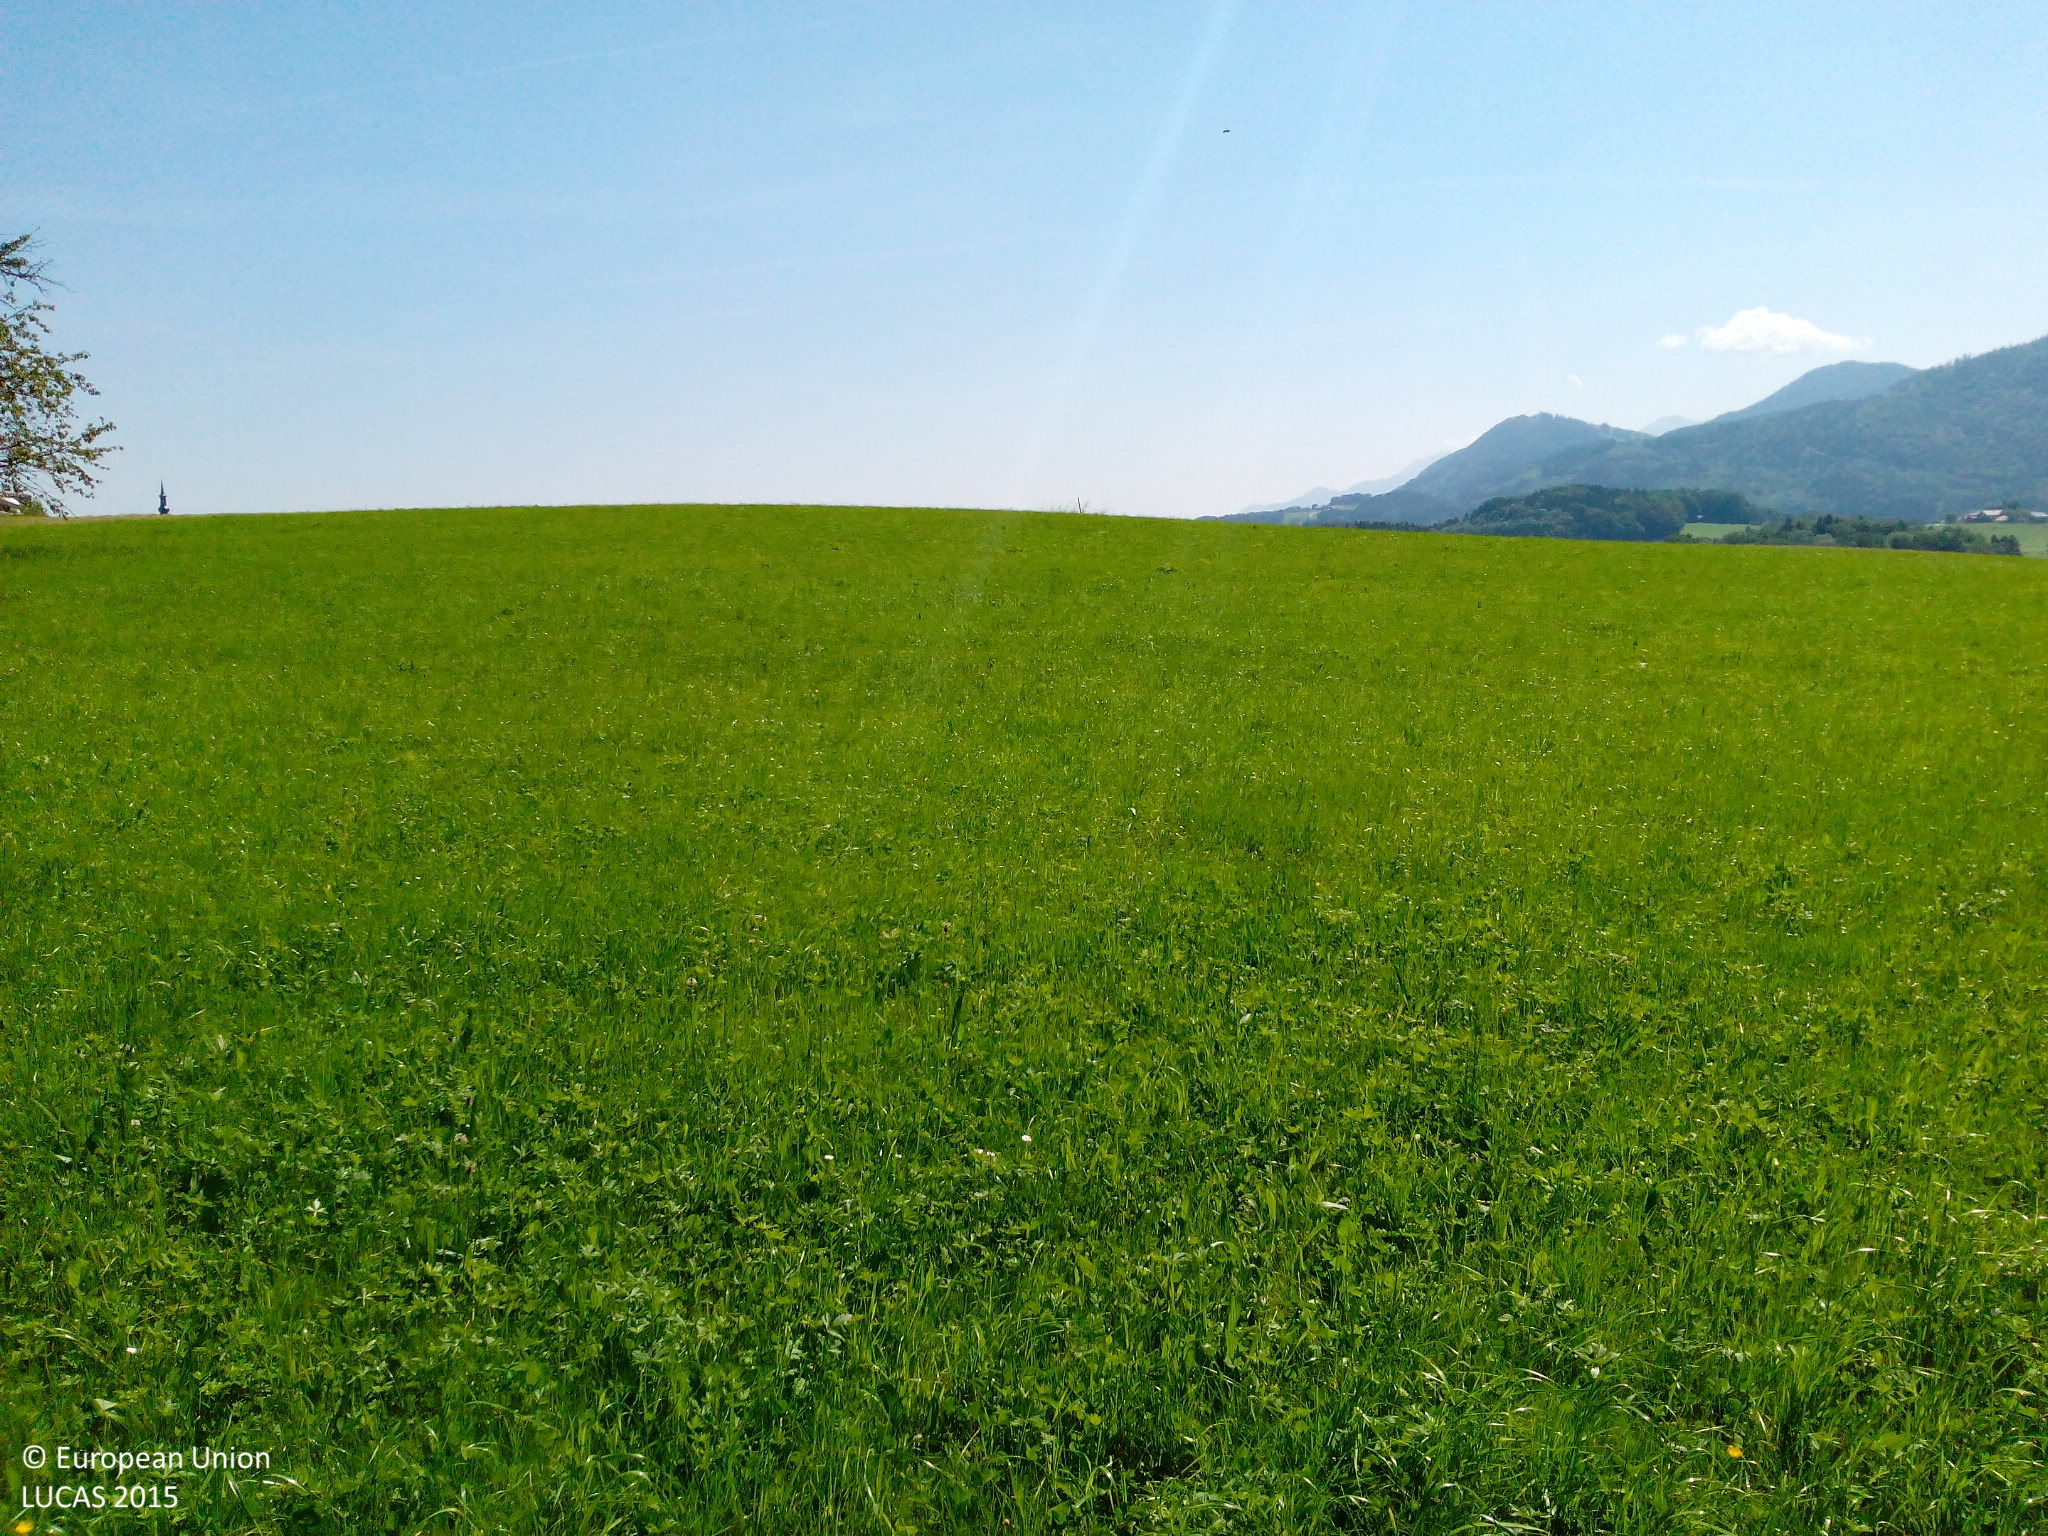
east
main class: Cropland
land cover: Apple fruit
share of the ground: 50 - 75 %
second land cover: Grassland without tree/shrub cover
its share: > 75 %
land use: Kitchen garden
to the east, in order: Apple fruit; Grassland without tree/shrub cover; Tracks; Grassland without tree/shrub cover
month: June
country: DE
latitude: 47.8033
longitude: 12.3086
